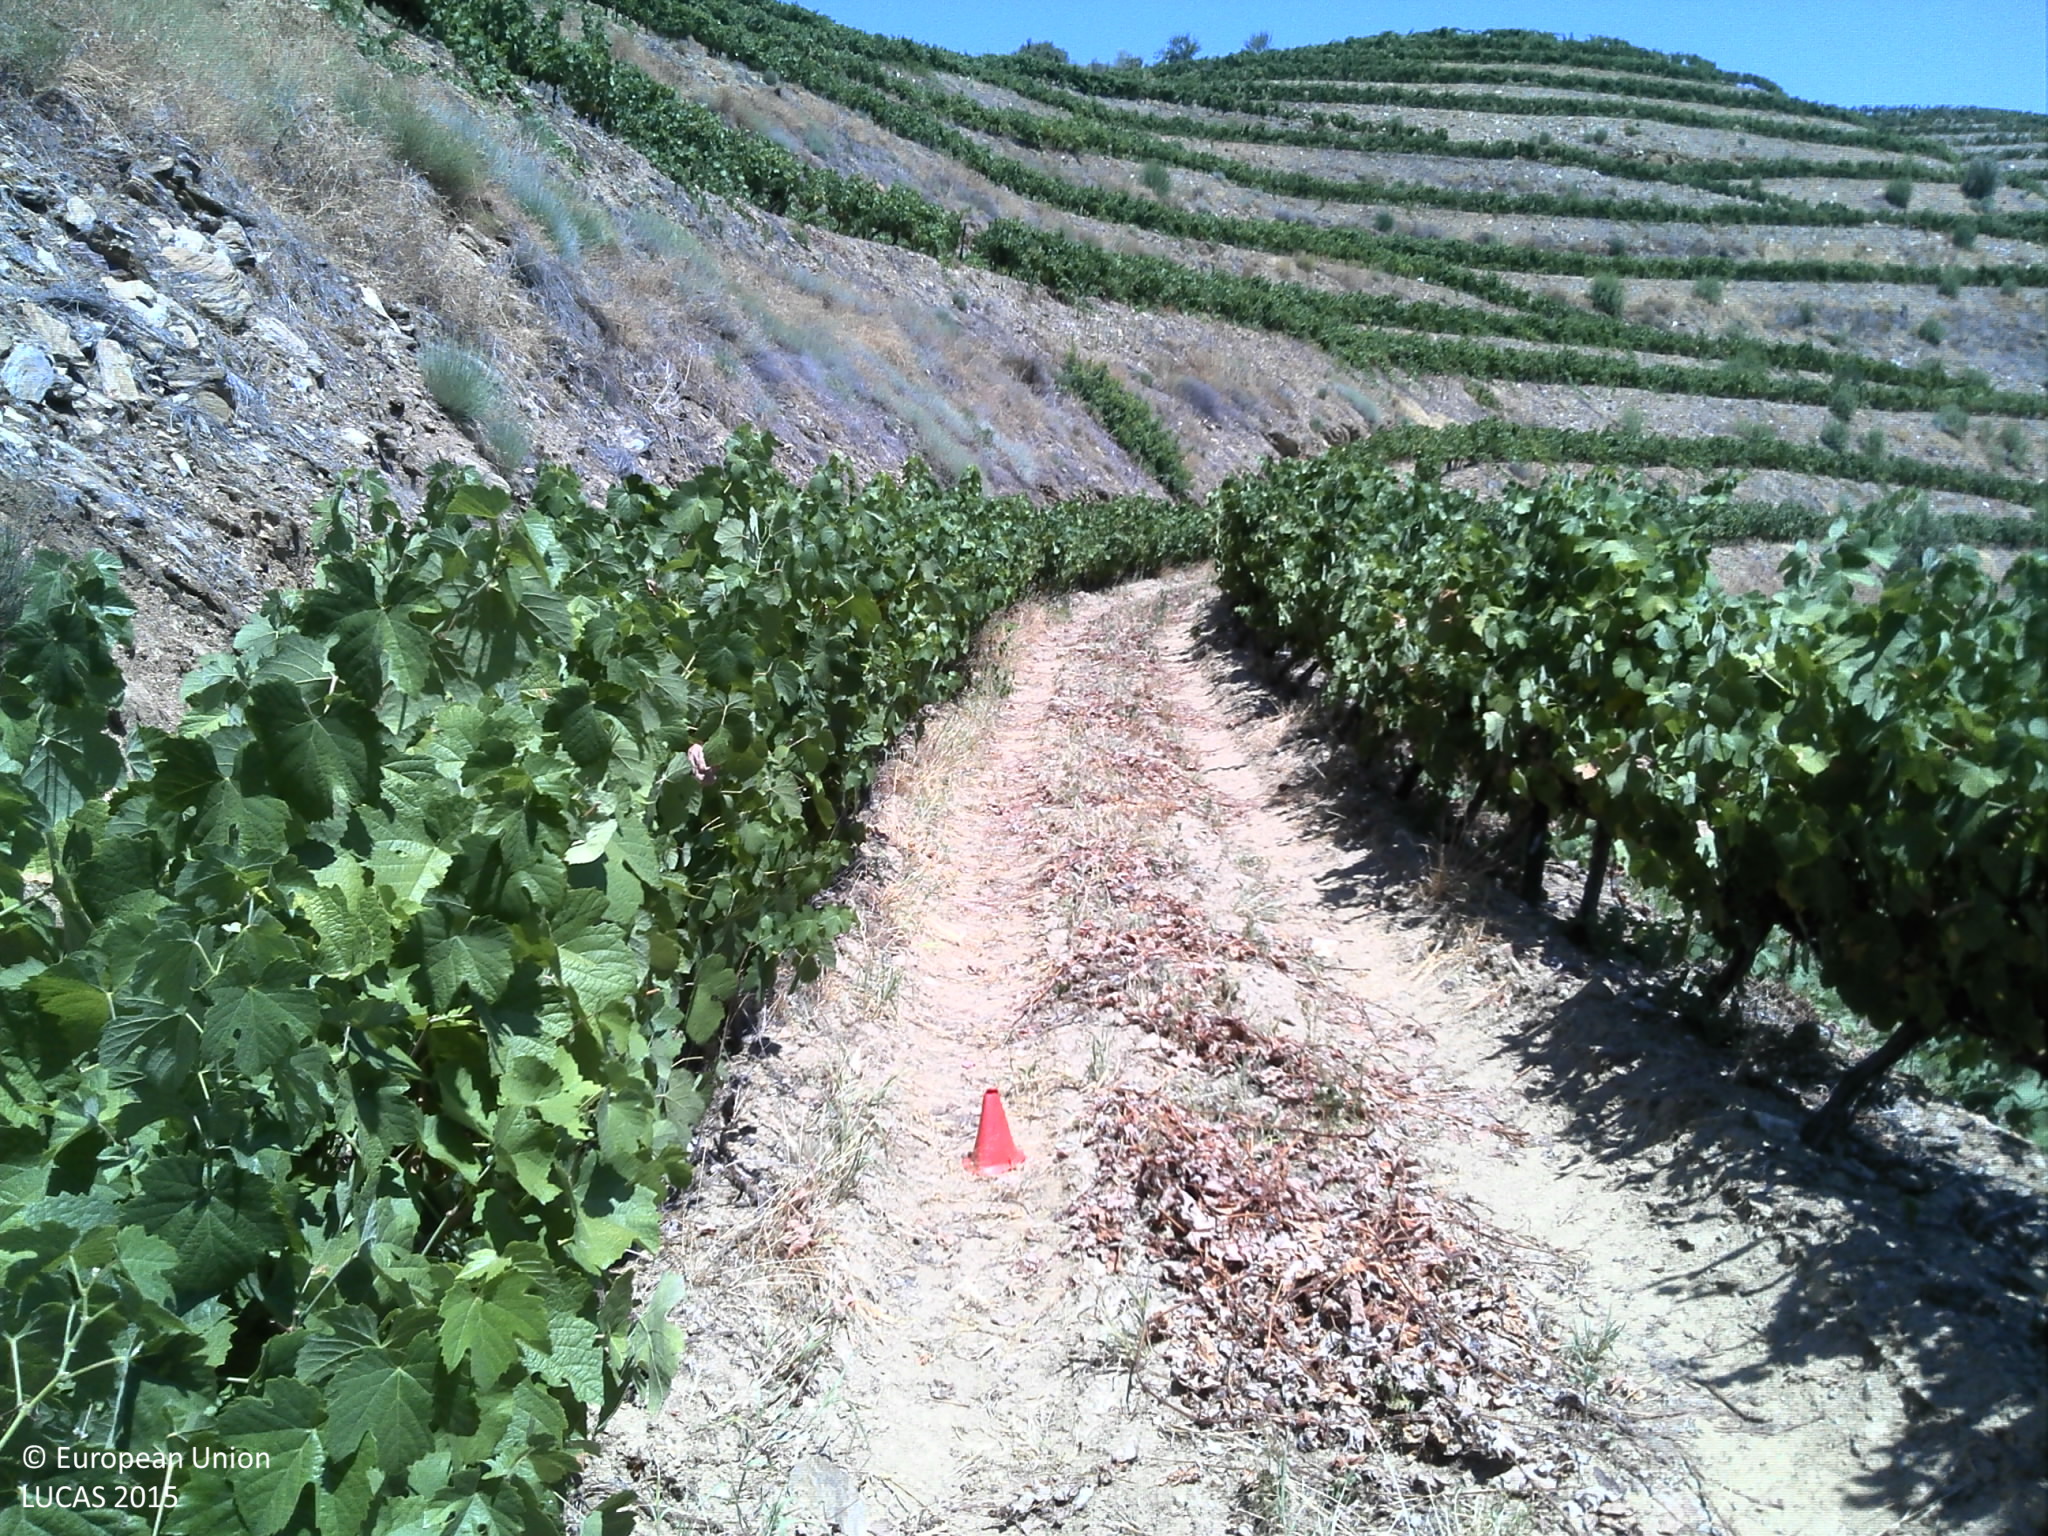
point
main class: Cropland
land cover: Vineyards
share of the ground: < 10 %
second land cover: Other bare soil
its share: > 75 %
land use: Agriculture (excluding fallow land and kitchen gardens)
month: July
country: PT
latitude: 40.9827
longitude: -7.2149
